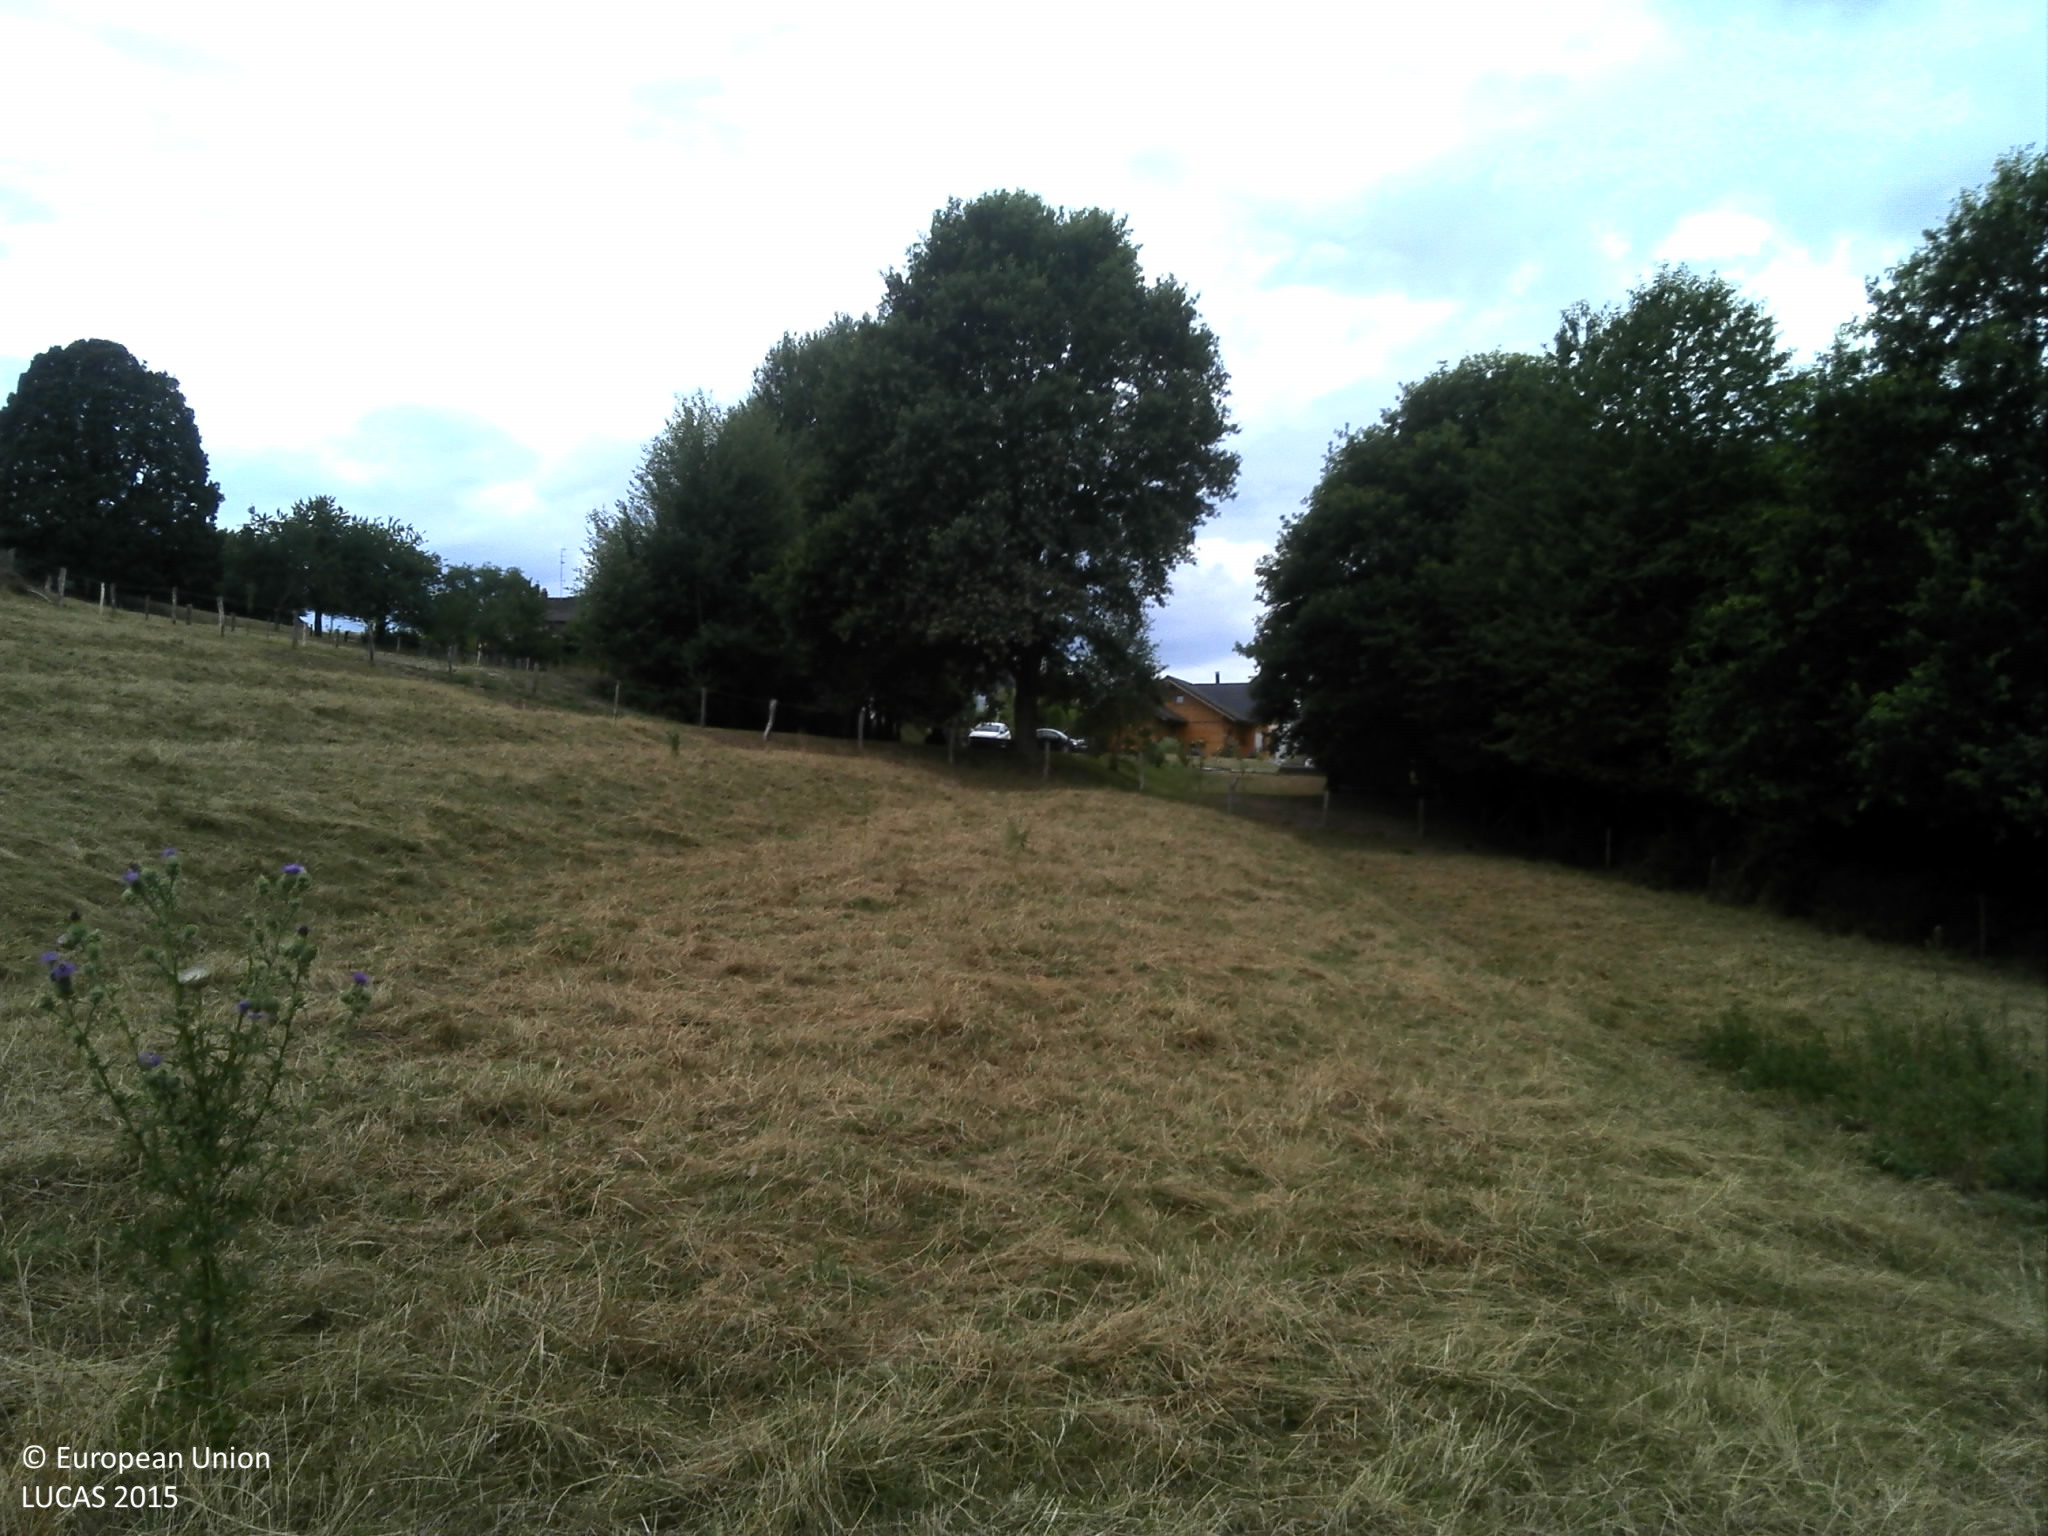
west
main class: Grassland
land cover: Grassland without tree/shrub cover
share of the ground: > 75 %
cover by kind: herbaceous plants 100 %
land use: Agriculture (excluding fallow land and kitchen gardens)
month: July
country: FR
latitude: 48.7478
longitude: 7.2670
